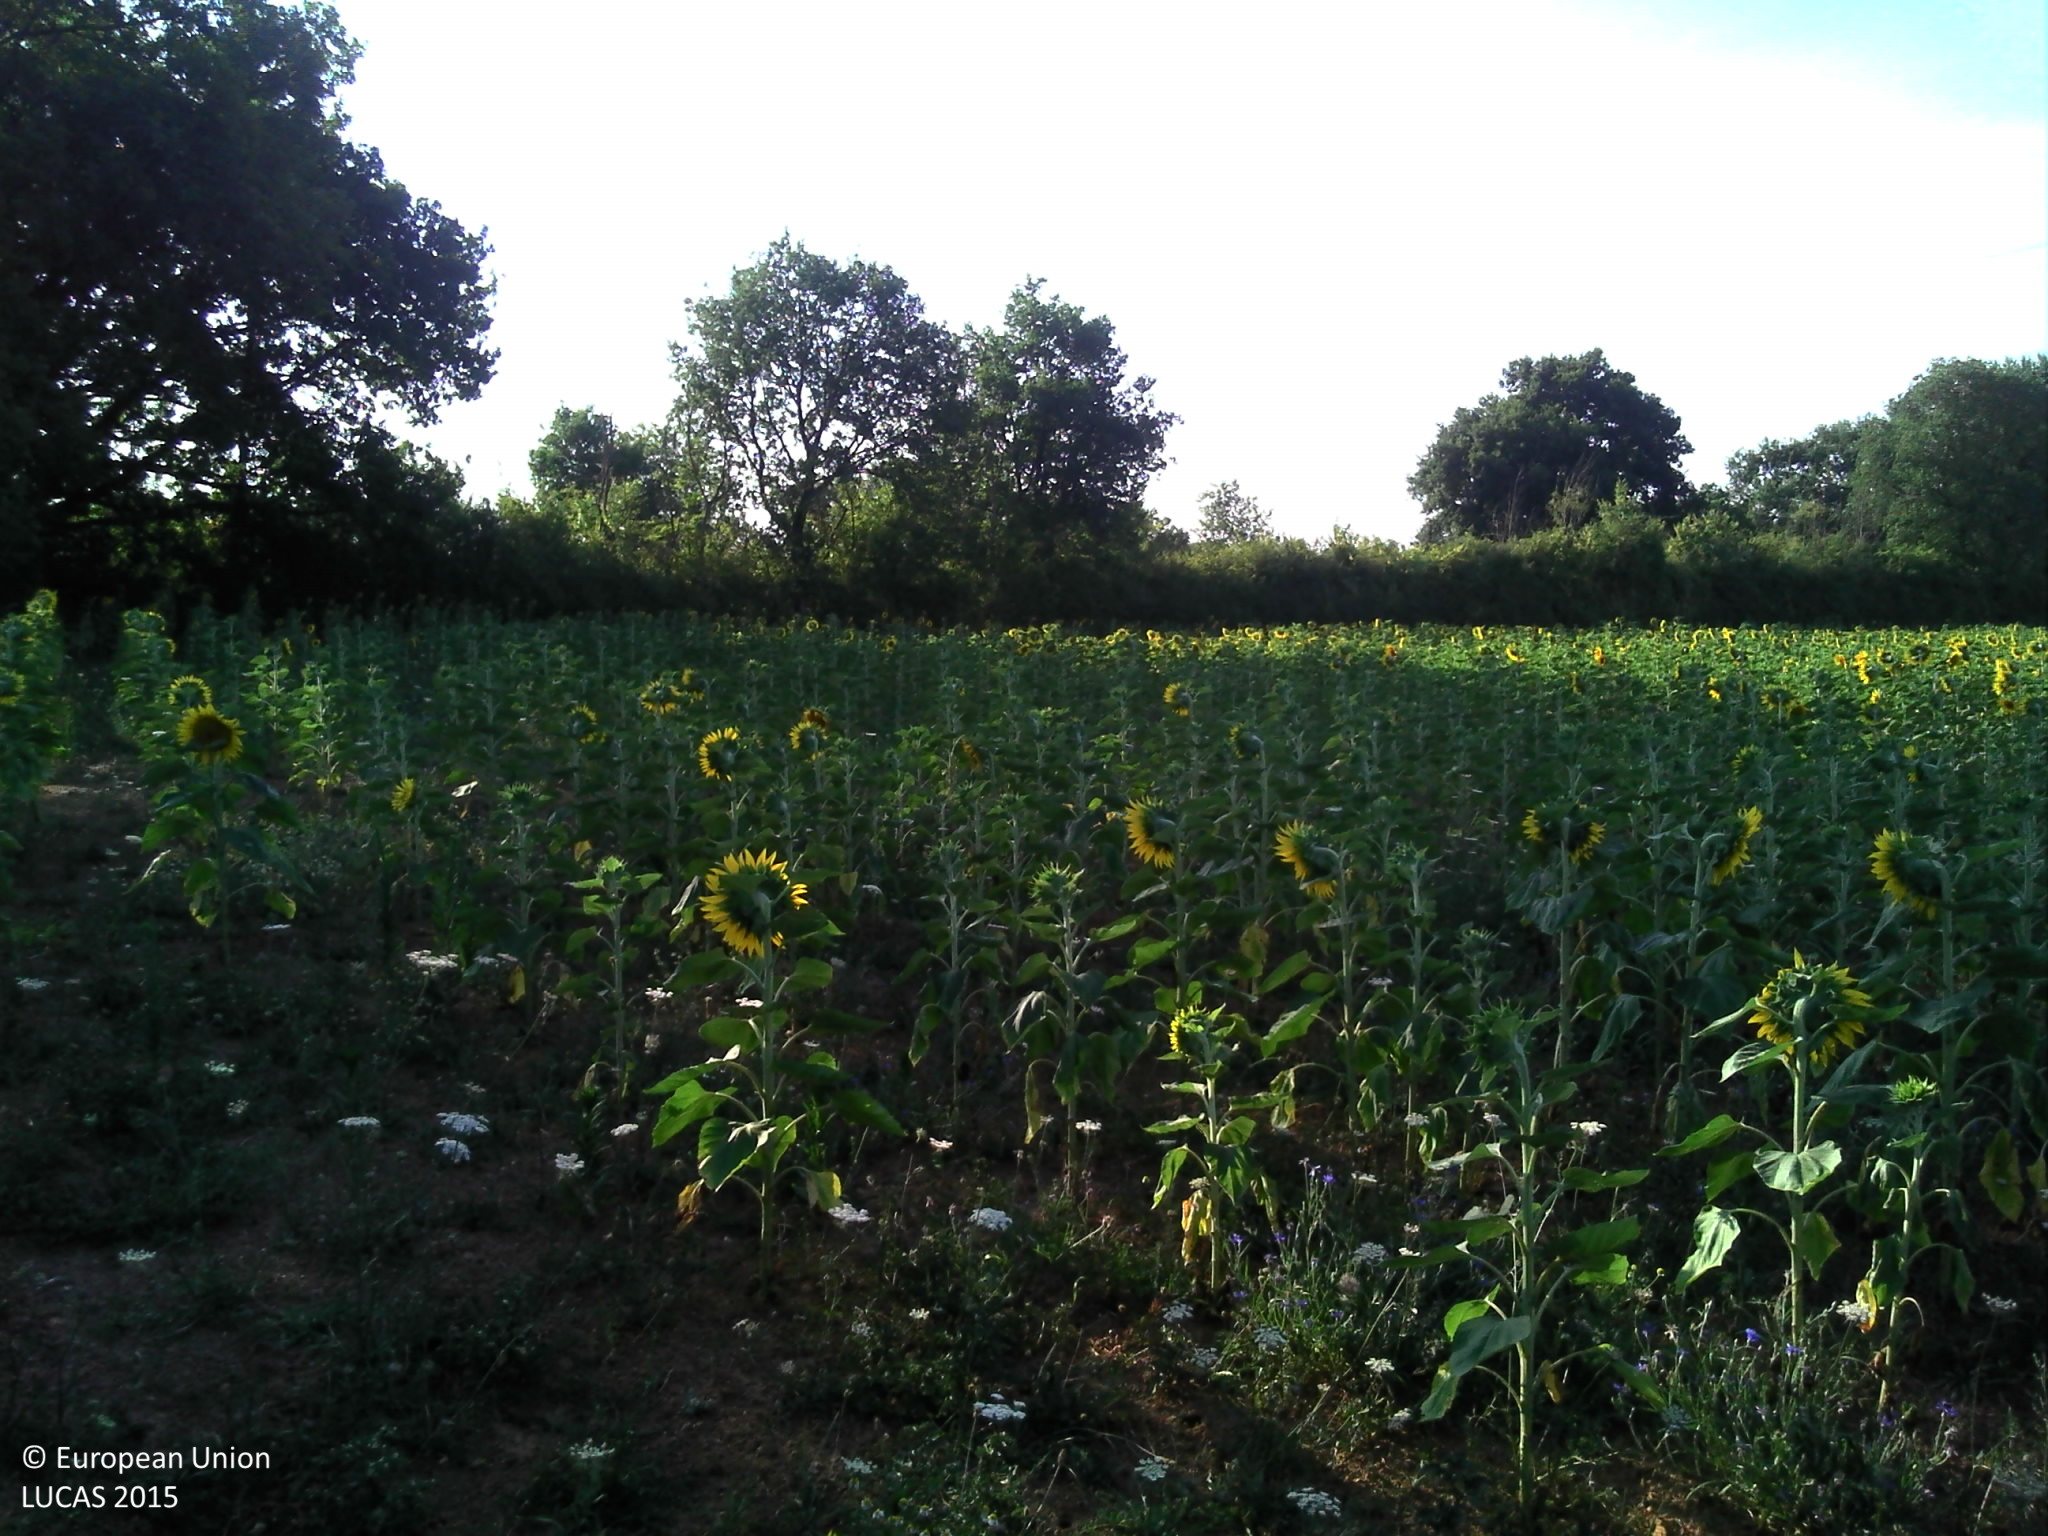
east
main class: Cropland
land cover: Sunflower
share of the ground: > 75 %
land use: Agriculture (excluding fallow land and kitchen gardens)
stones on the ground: < 10 %
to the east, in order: Sunflower; Broadleaved woodland; Sunflower; Electric lines; Sunflower; Abandoned hedges; Fences; Grassland without tree/shrub cover
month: July
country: FR
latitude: 46.3033
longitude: 0.6494
